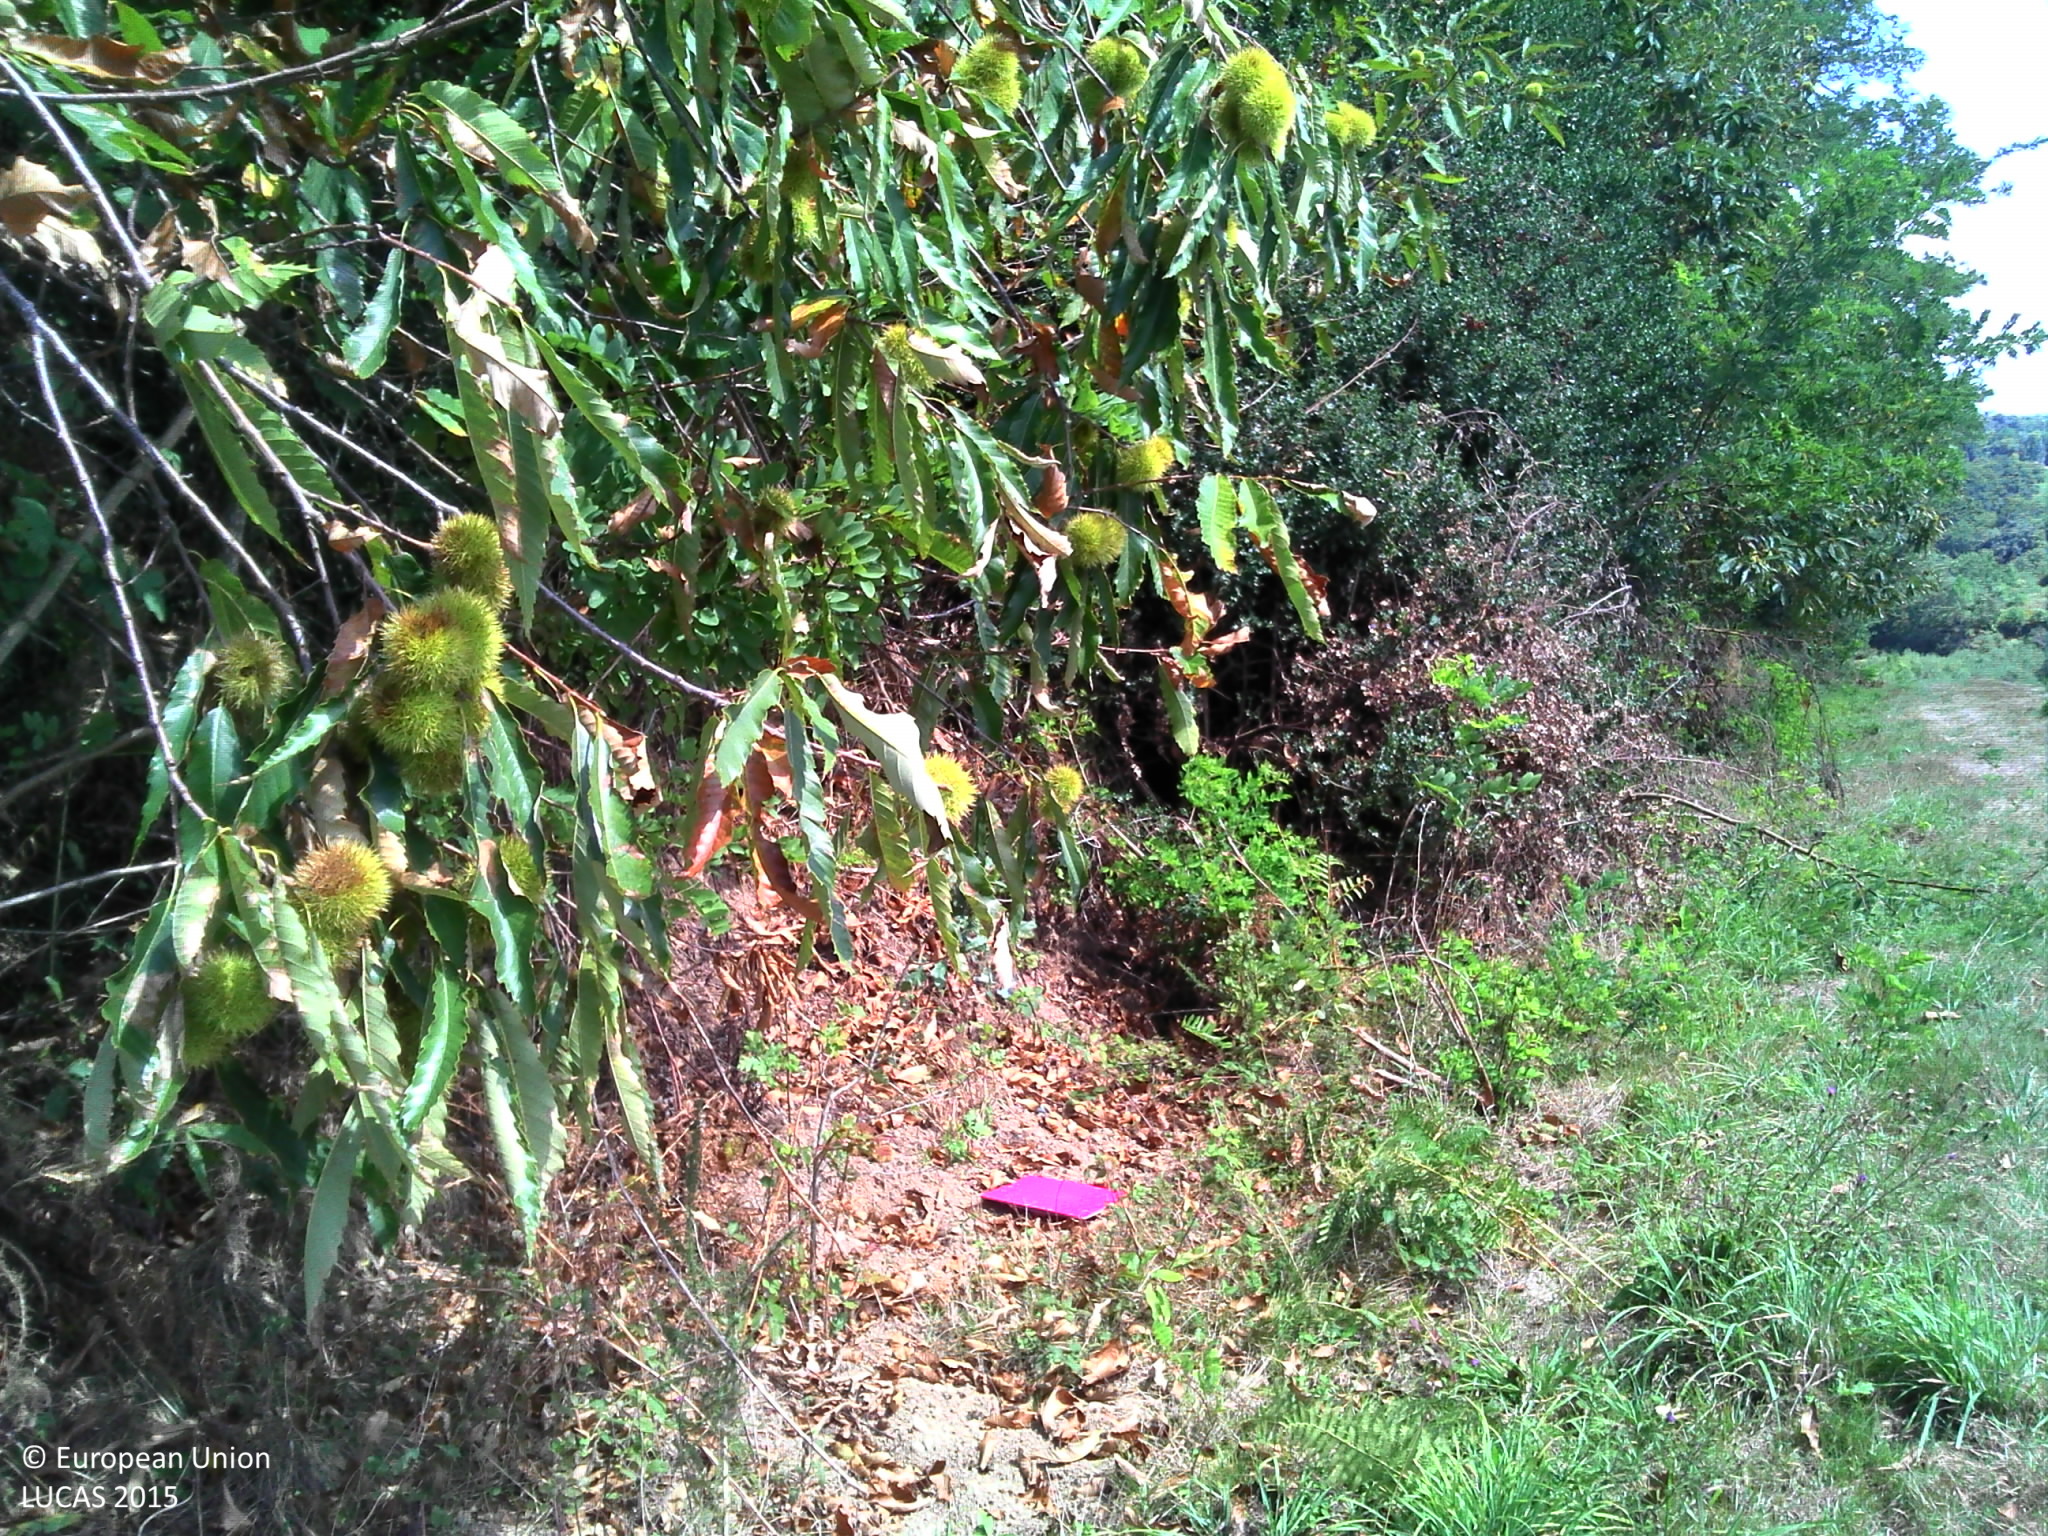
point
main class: Woodland
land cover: Broadleaved woodland
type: acidophilous oak and oak-birch forest
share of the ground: > 75 %
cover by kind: broadleaved forest trees 75 %, shrubs 10 %, herbaceous plants 10 %, lichens and mosses 5 %
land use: Forestry
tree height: > 5 m
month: September
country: FR
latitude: 43.4956
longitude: -0.9577
